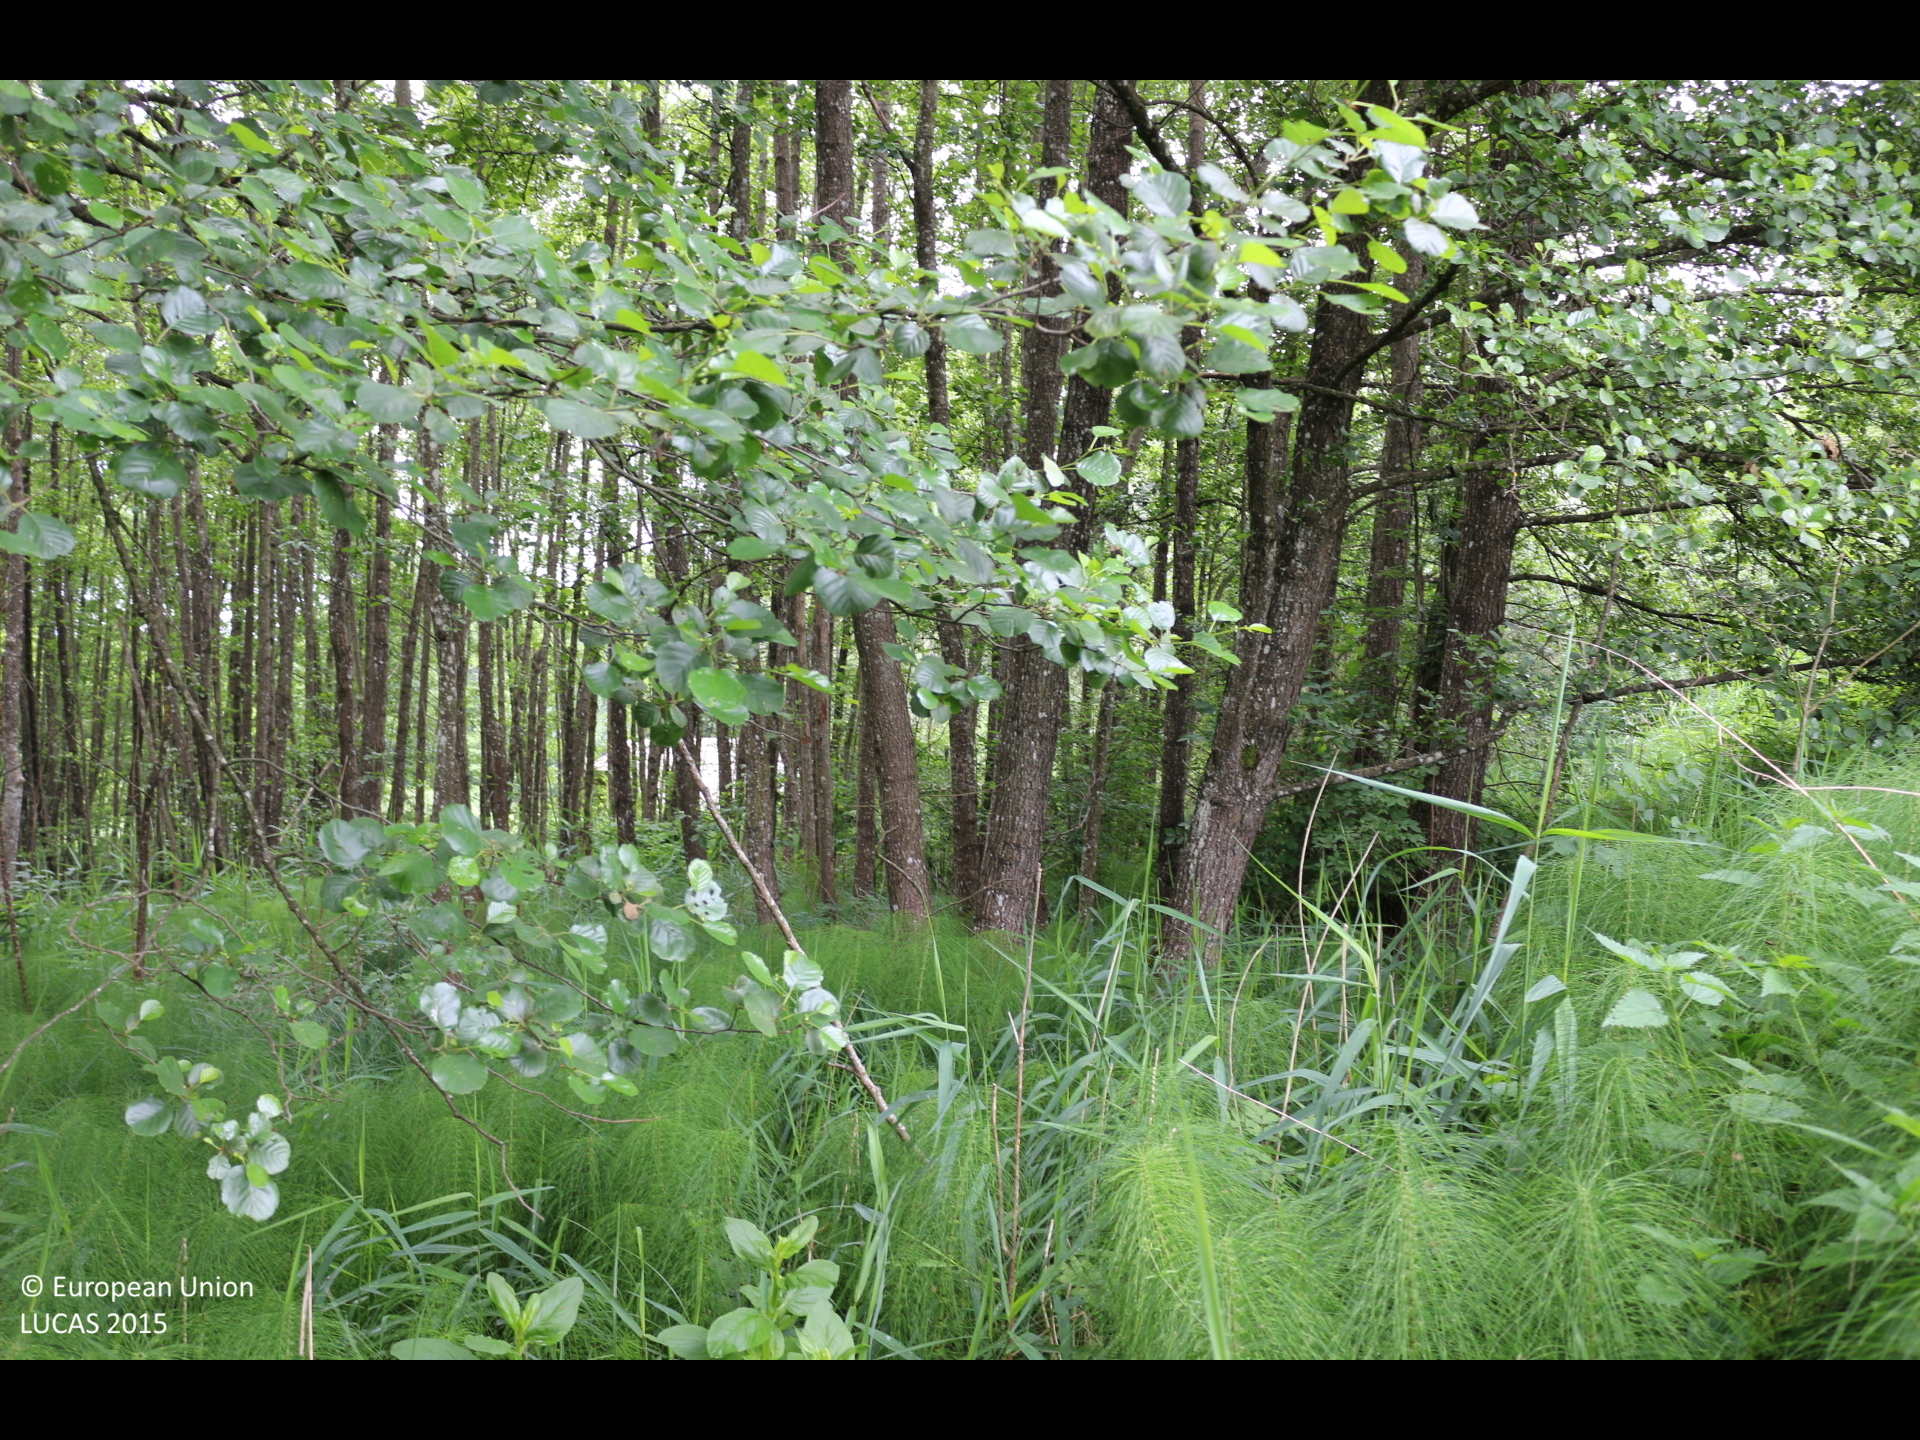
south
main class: Woodland
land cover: Broadleaved woodland
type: floodplain forest
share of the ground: > 75 %
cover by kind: broadleaved forest trees 100 %
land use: Forestry
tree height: > 5 m
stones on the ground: 10 - 25 %
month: June
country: AT
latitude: 46.7145
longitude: 14.3277
